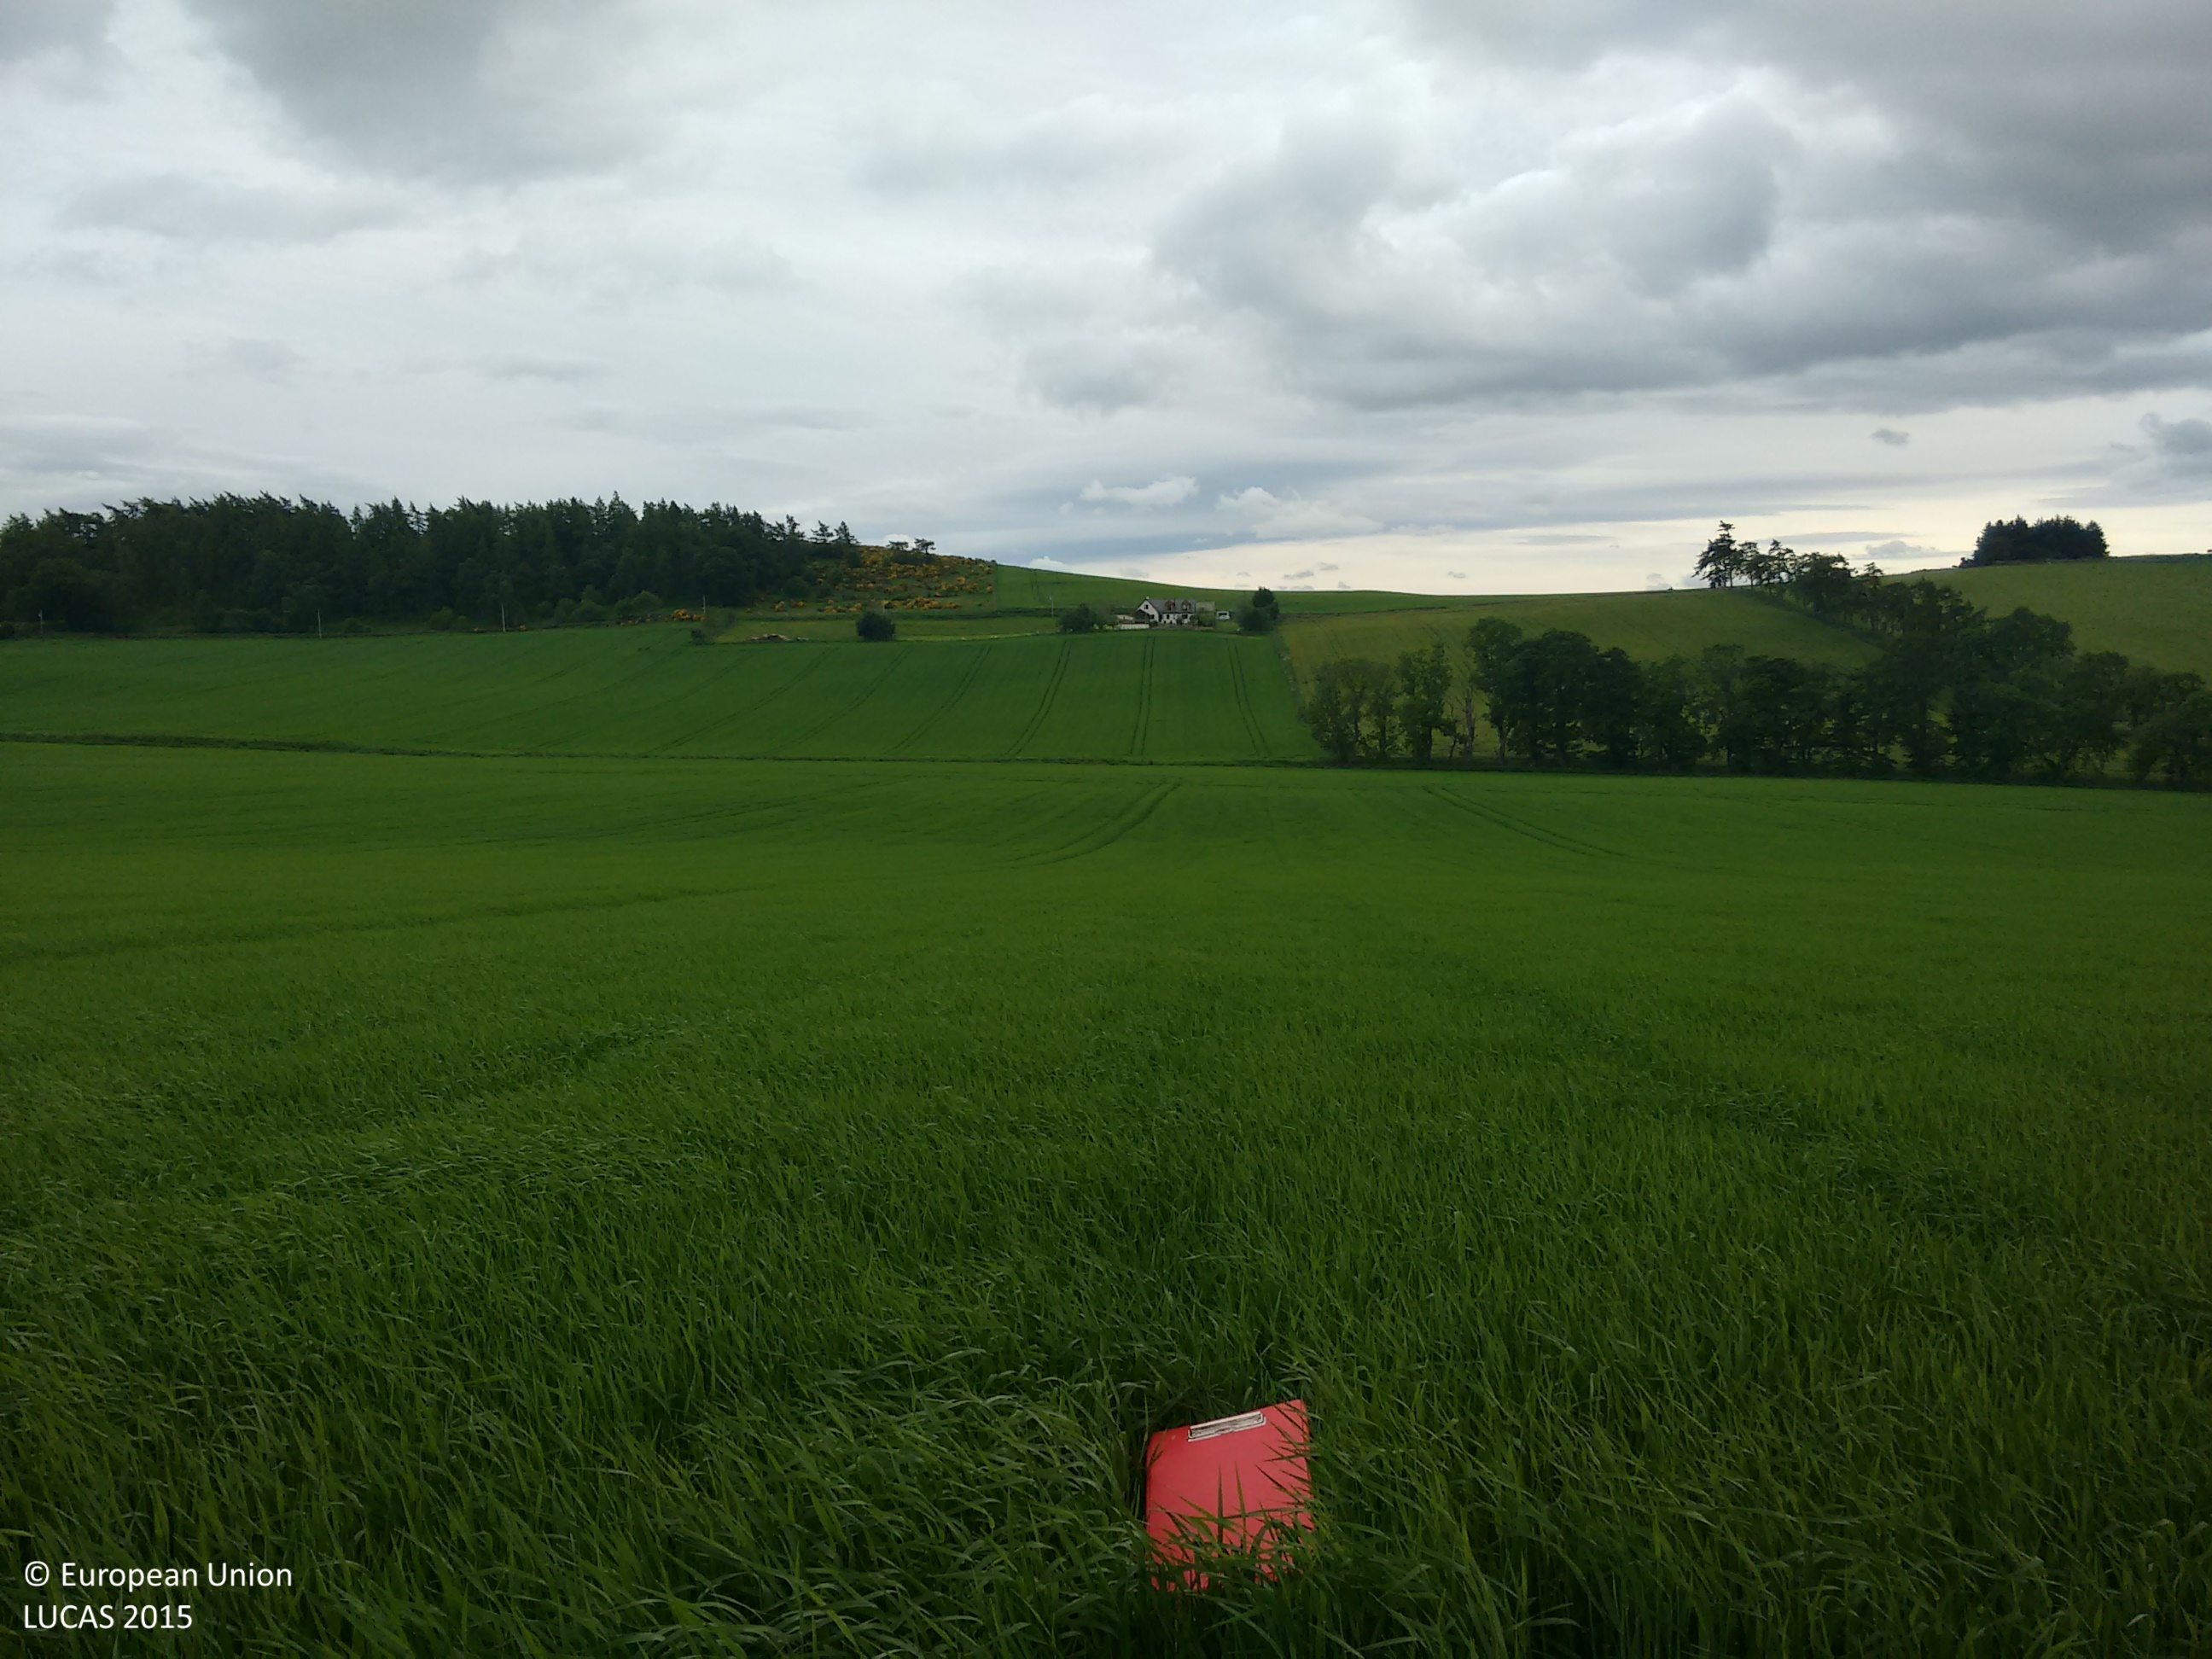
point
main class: Cropland
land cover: Barley
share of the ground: > 75 %
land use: Agriculture (excluding fallow land and kitchen gardens)
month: June
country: GB
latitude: 57.2103
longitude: -2.7233
